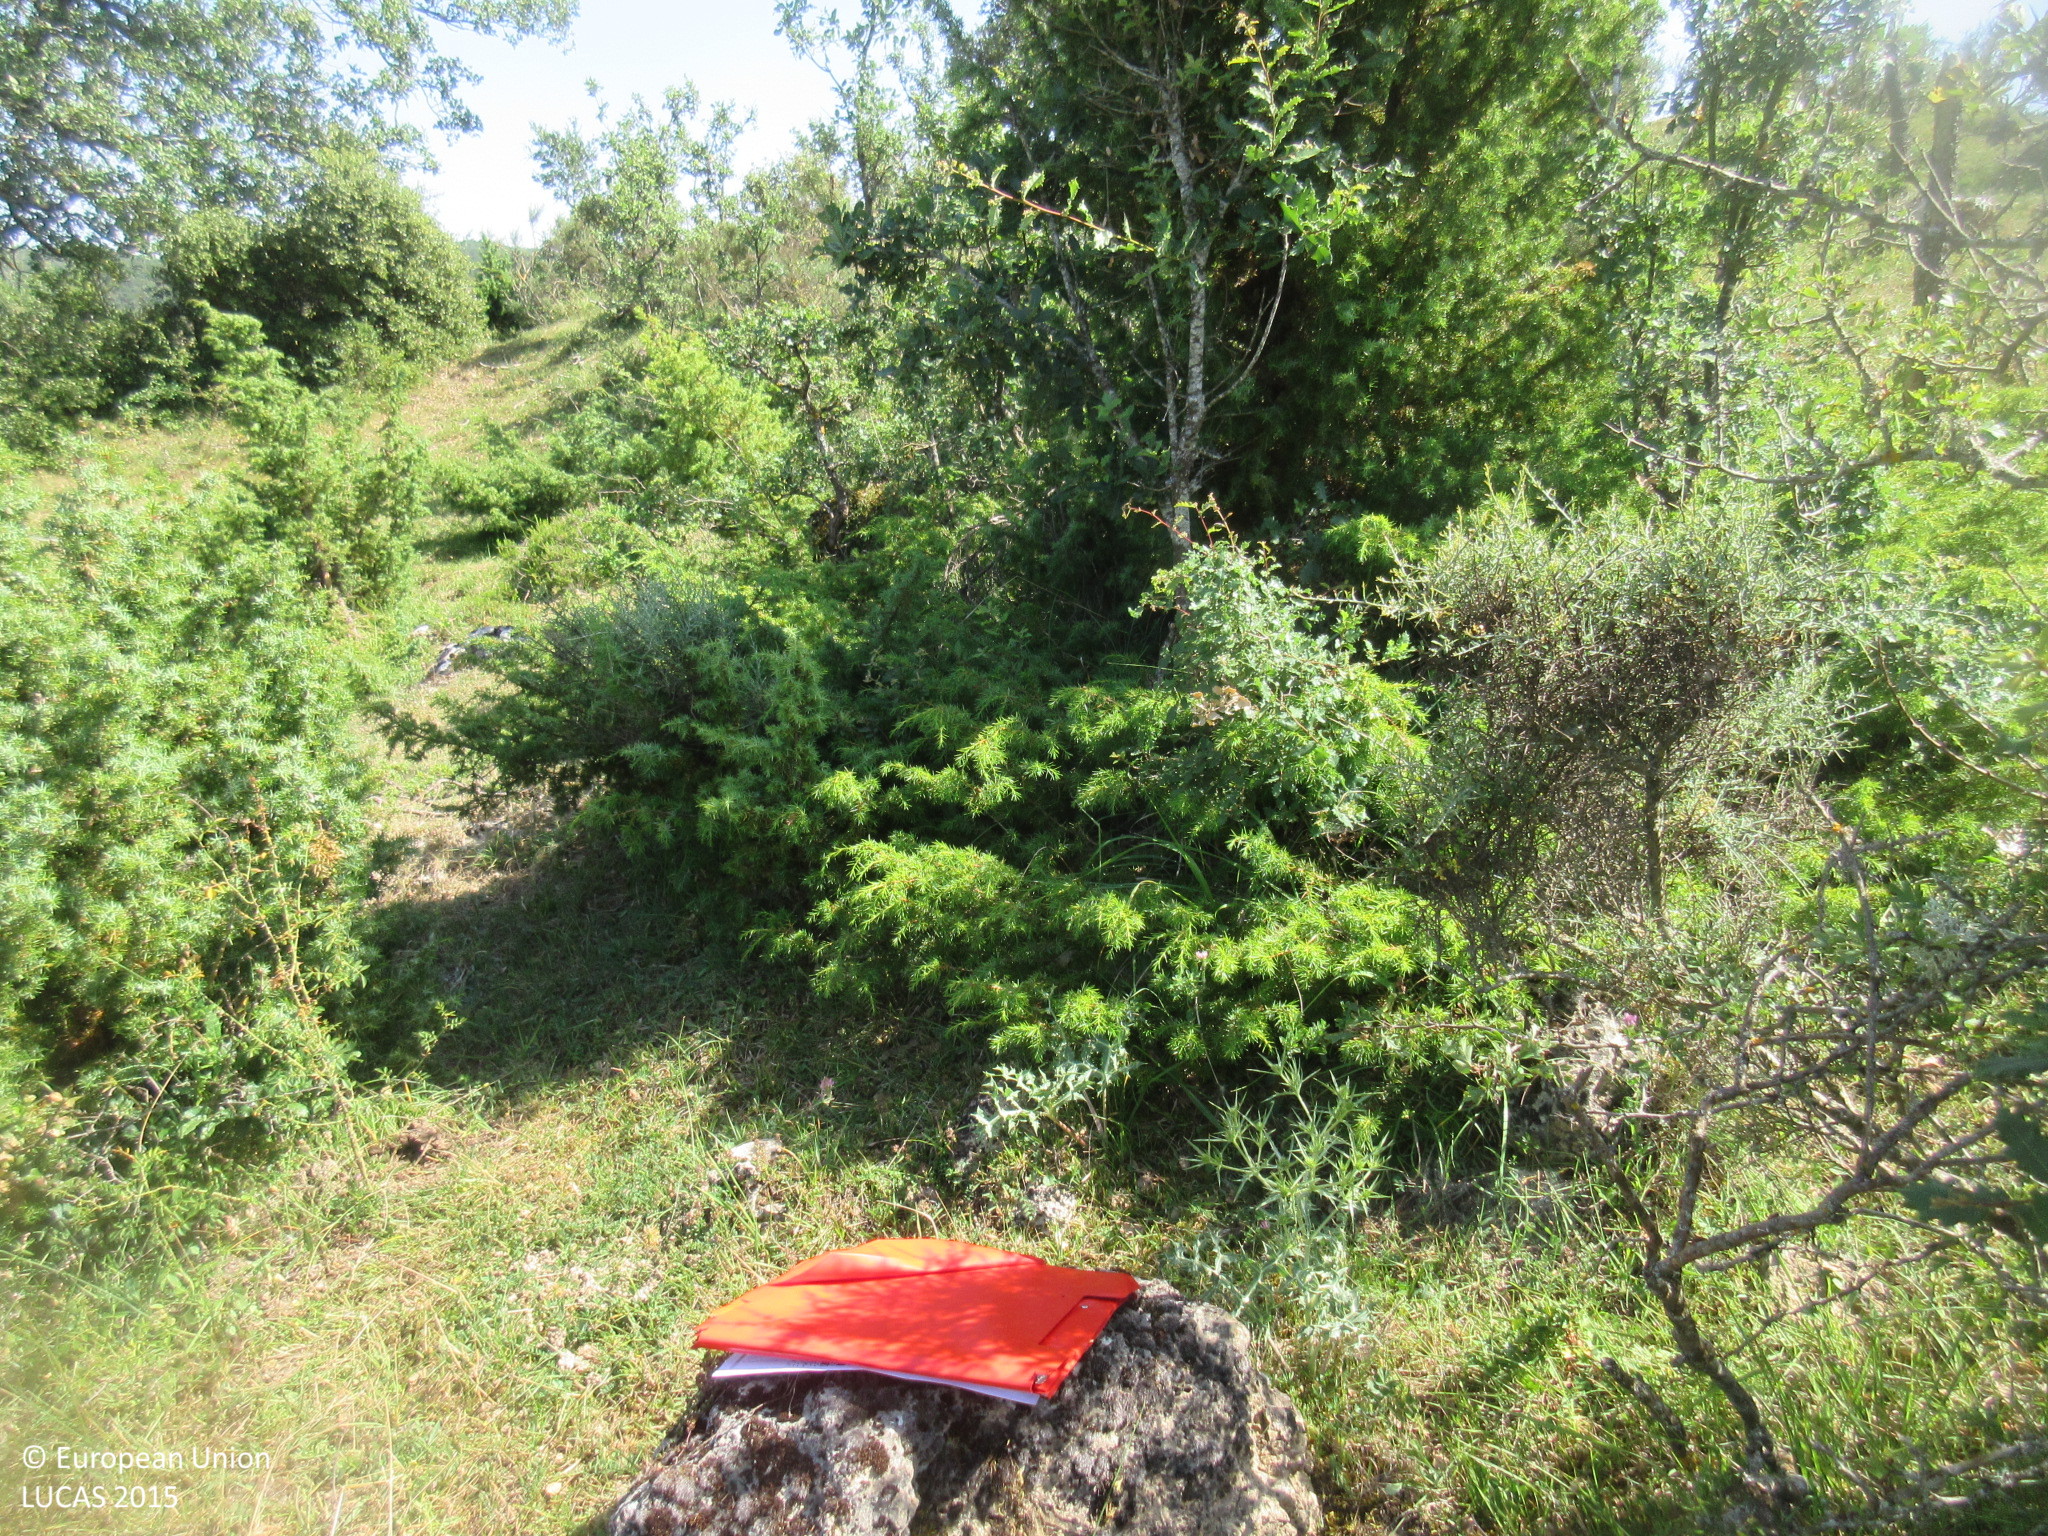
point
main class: Grassland
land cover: Grassland with sparse tree/shrub cover
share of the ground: > 75 %
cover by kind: herbaceous plants 90 %, broadleaved forest trees 5 %, shrubs 5 %
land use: Agriculture (excluding fallow land and kitchen gardens)
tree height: > 5 m
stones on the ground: 10 - 25 %
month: July
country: ES
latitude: 42.9427
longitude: -3.4334
